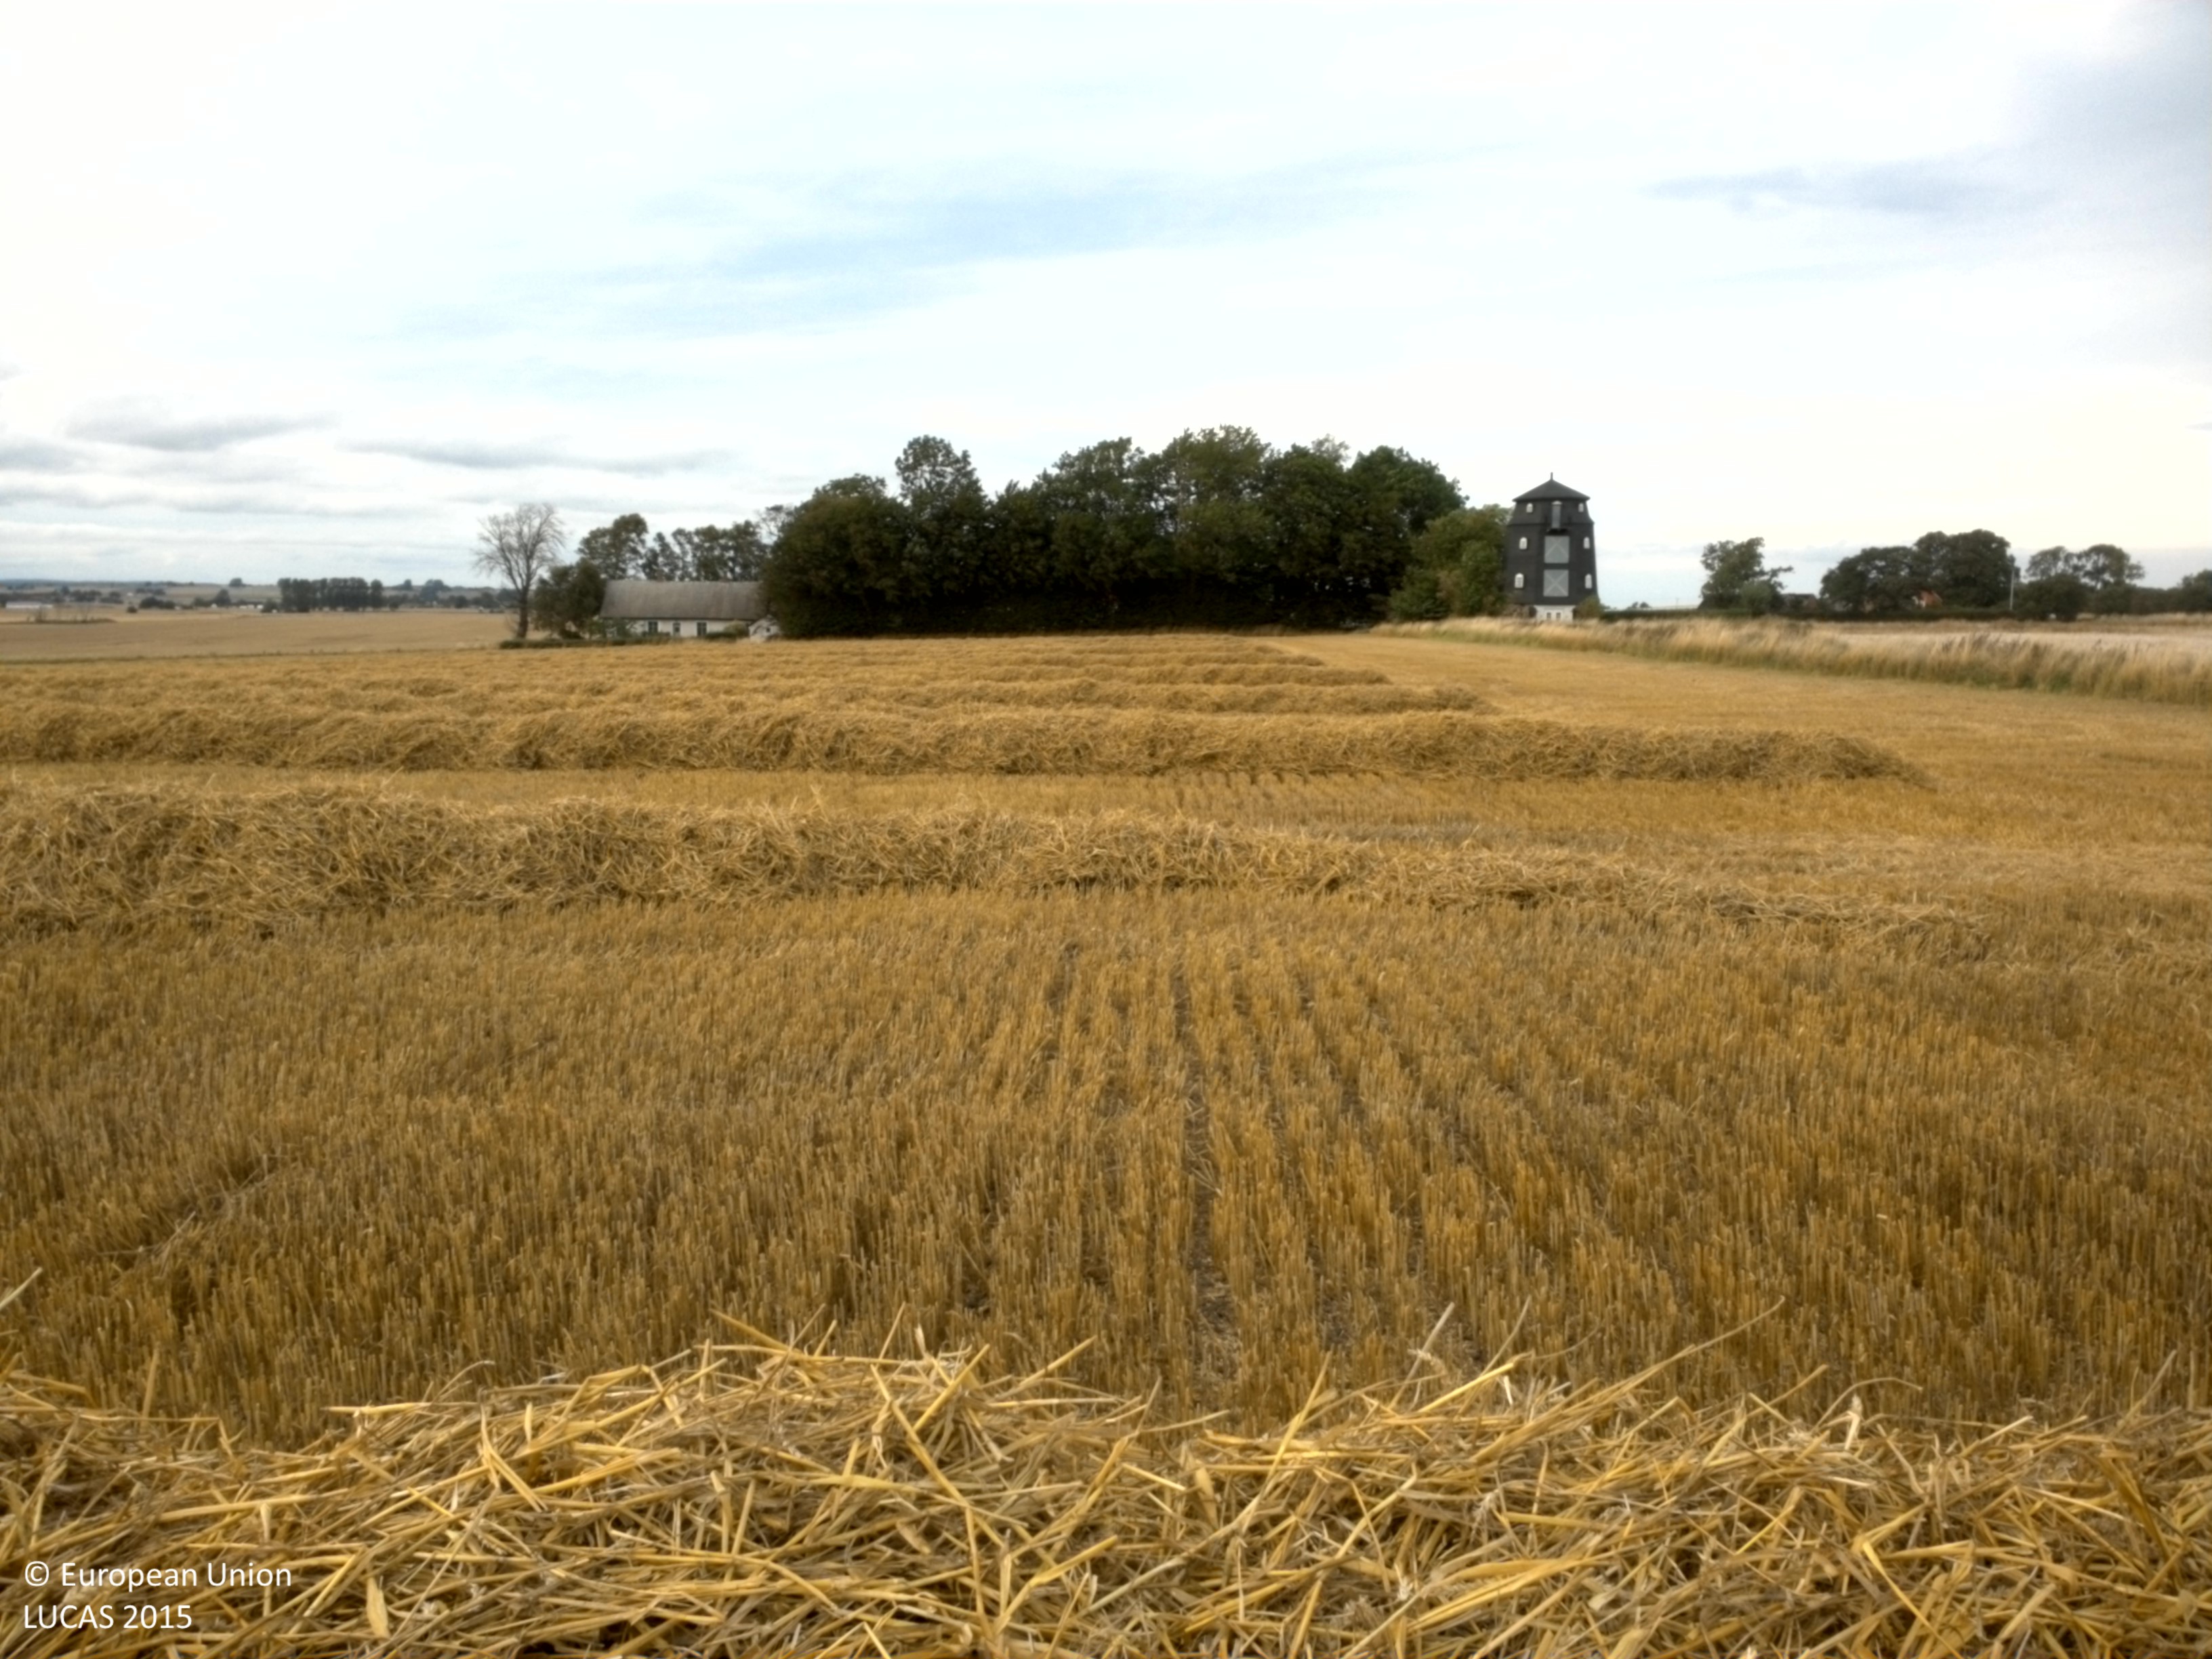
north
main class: Cropland
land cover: Common wheat
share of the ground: 25 - 50 %
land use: Agriculture (excluding fallow land and kitchen gardens)
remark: Harvested field
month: September
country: SE
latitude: 55.5040
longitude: 14.2894
